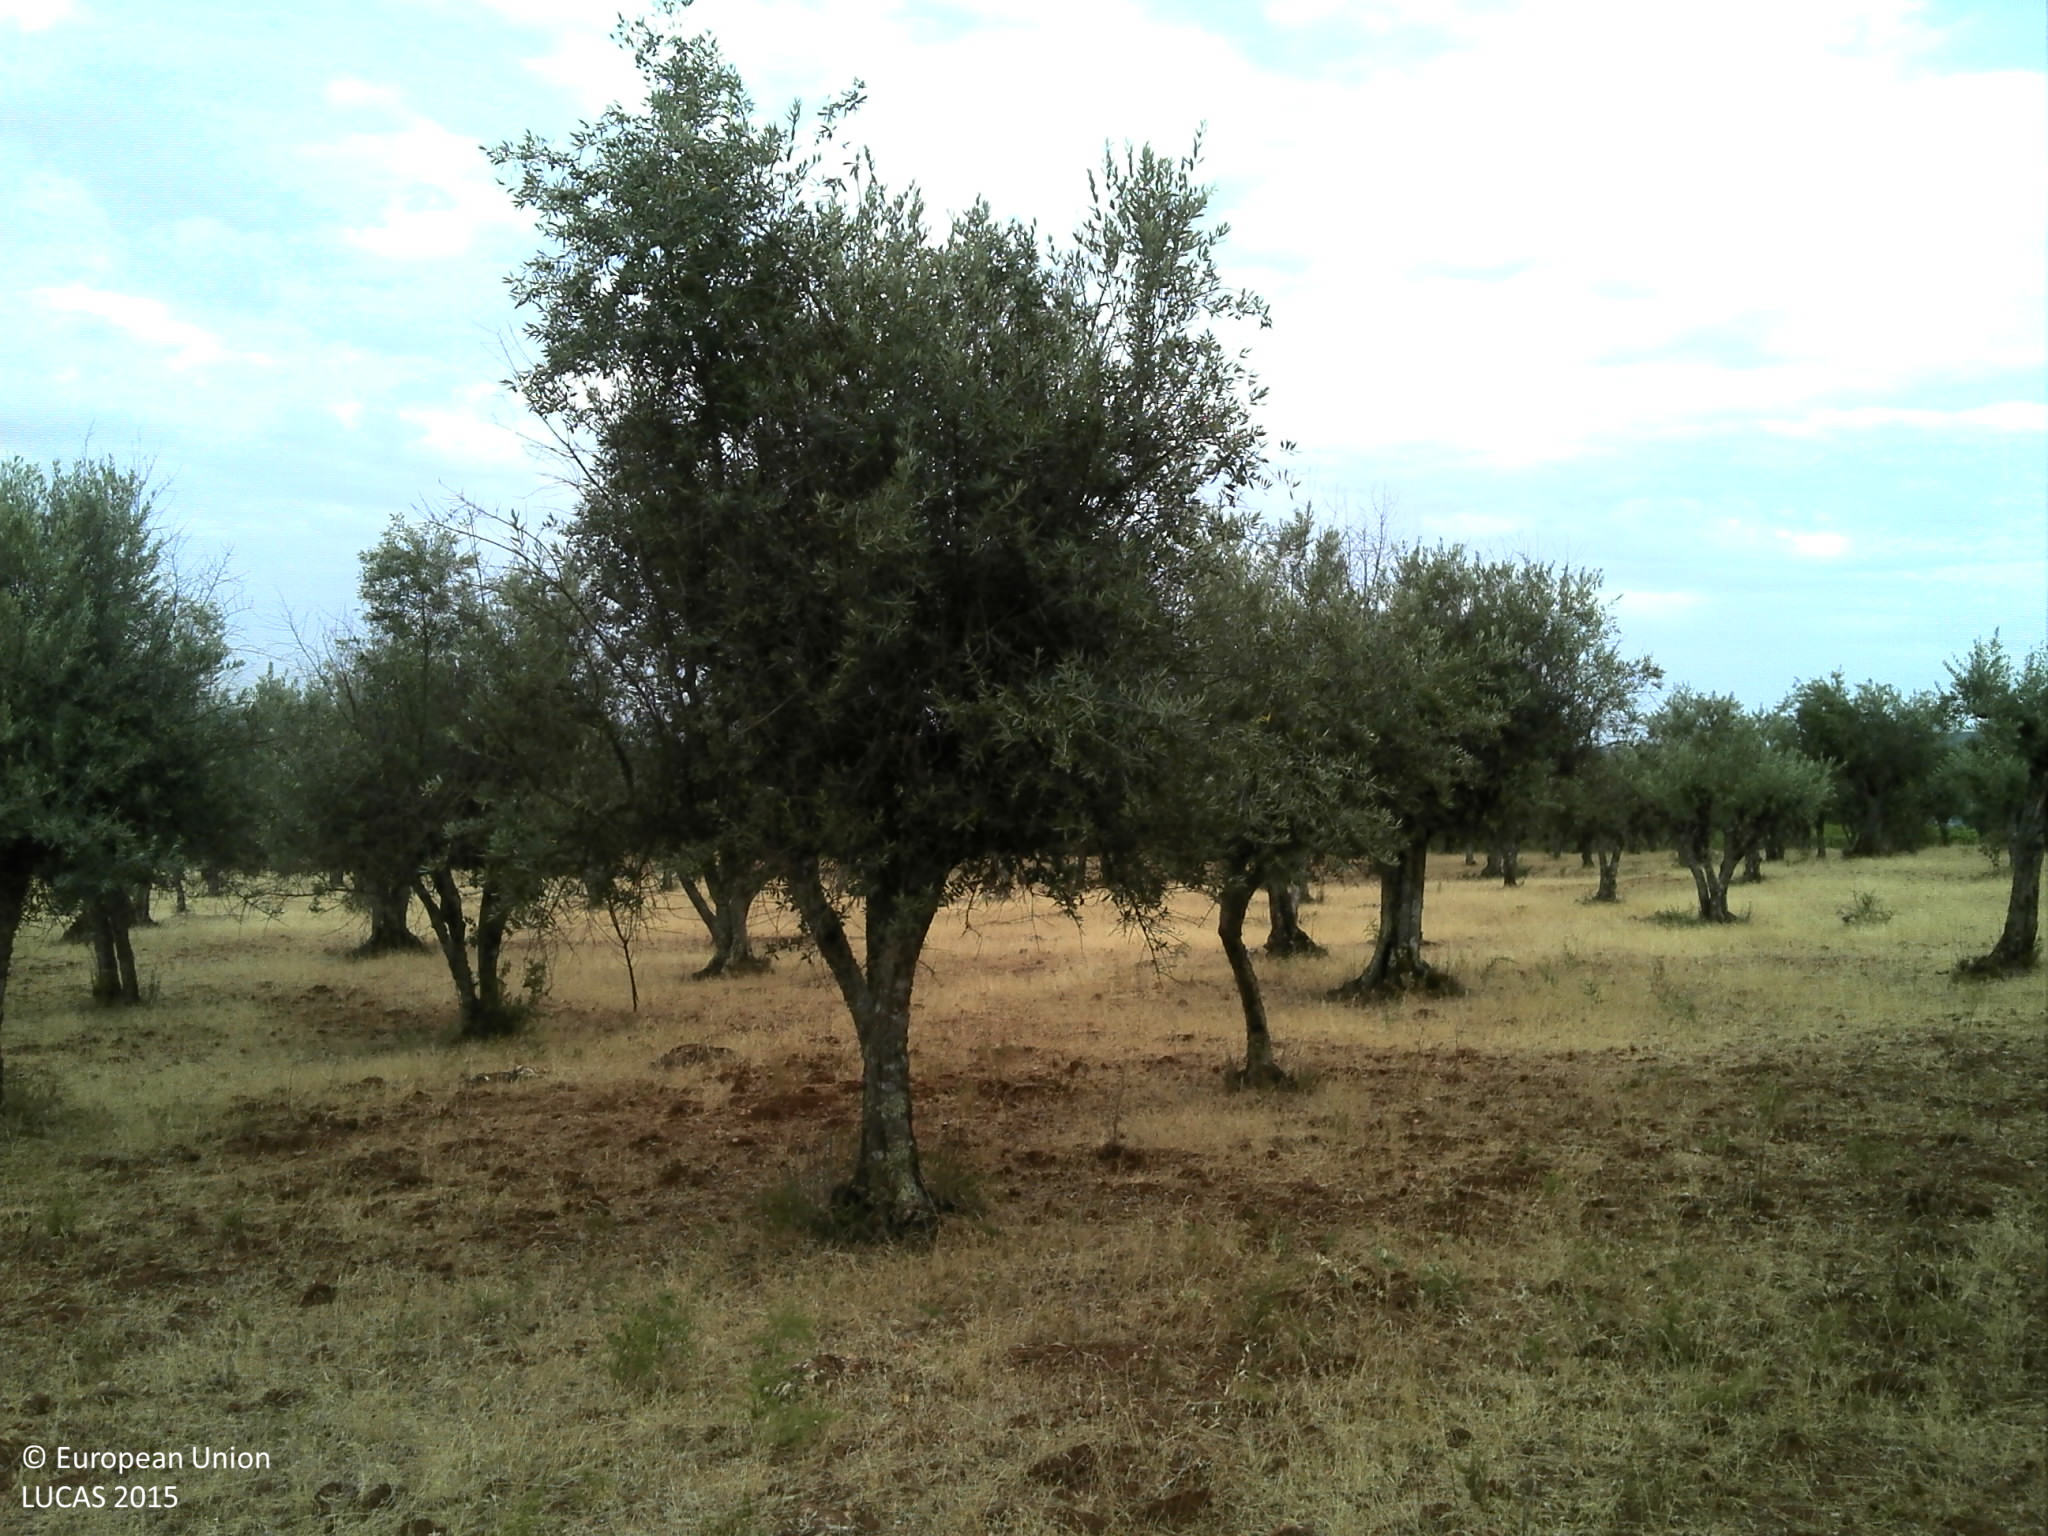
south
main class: Cropland
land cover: Olive groves
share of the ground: 25 - 50 %
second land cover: Grassland without tree/shrub cover
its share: 25 - 50 %
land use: Agriculture (excluding fallow land and kitchen gardens)
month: July
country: PT
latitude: 38.7915
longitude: -7.4991
